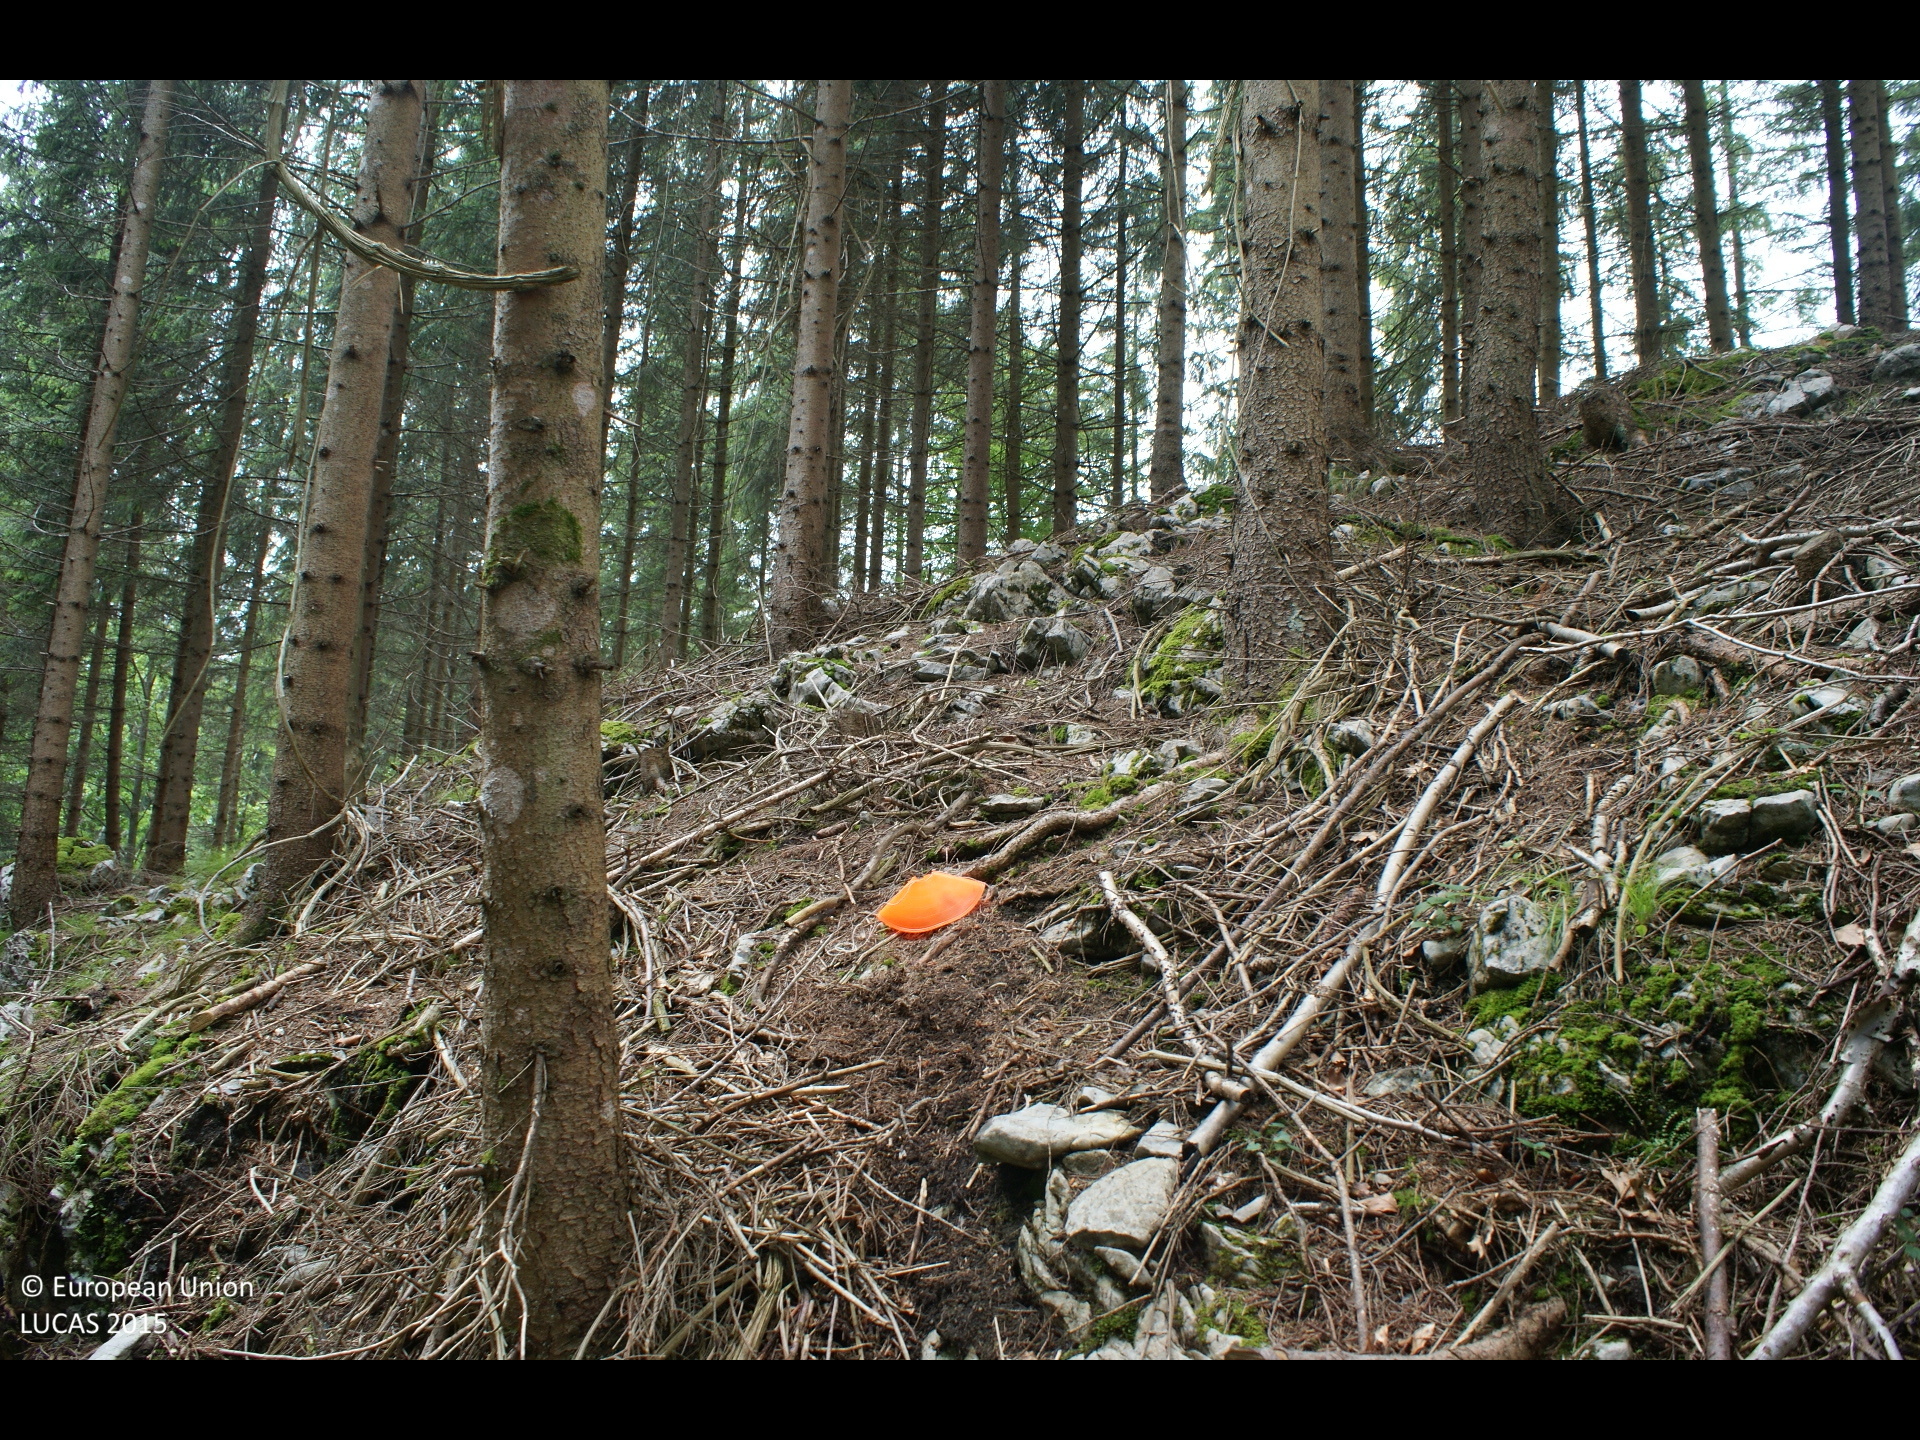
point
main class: Woodland
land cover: Spruce dominated coniferous woodland
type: alpine coniferous forest
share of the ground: > 75 %
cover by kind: coniferous forest trees 80 %, unconsolidated bare surface 10 %, broadleaved forest trees 5 %, herbaceous plants 5 %
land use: Forestry
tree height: > 5 m
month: July
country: AT
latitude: 47.7878
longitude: 14.9525
